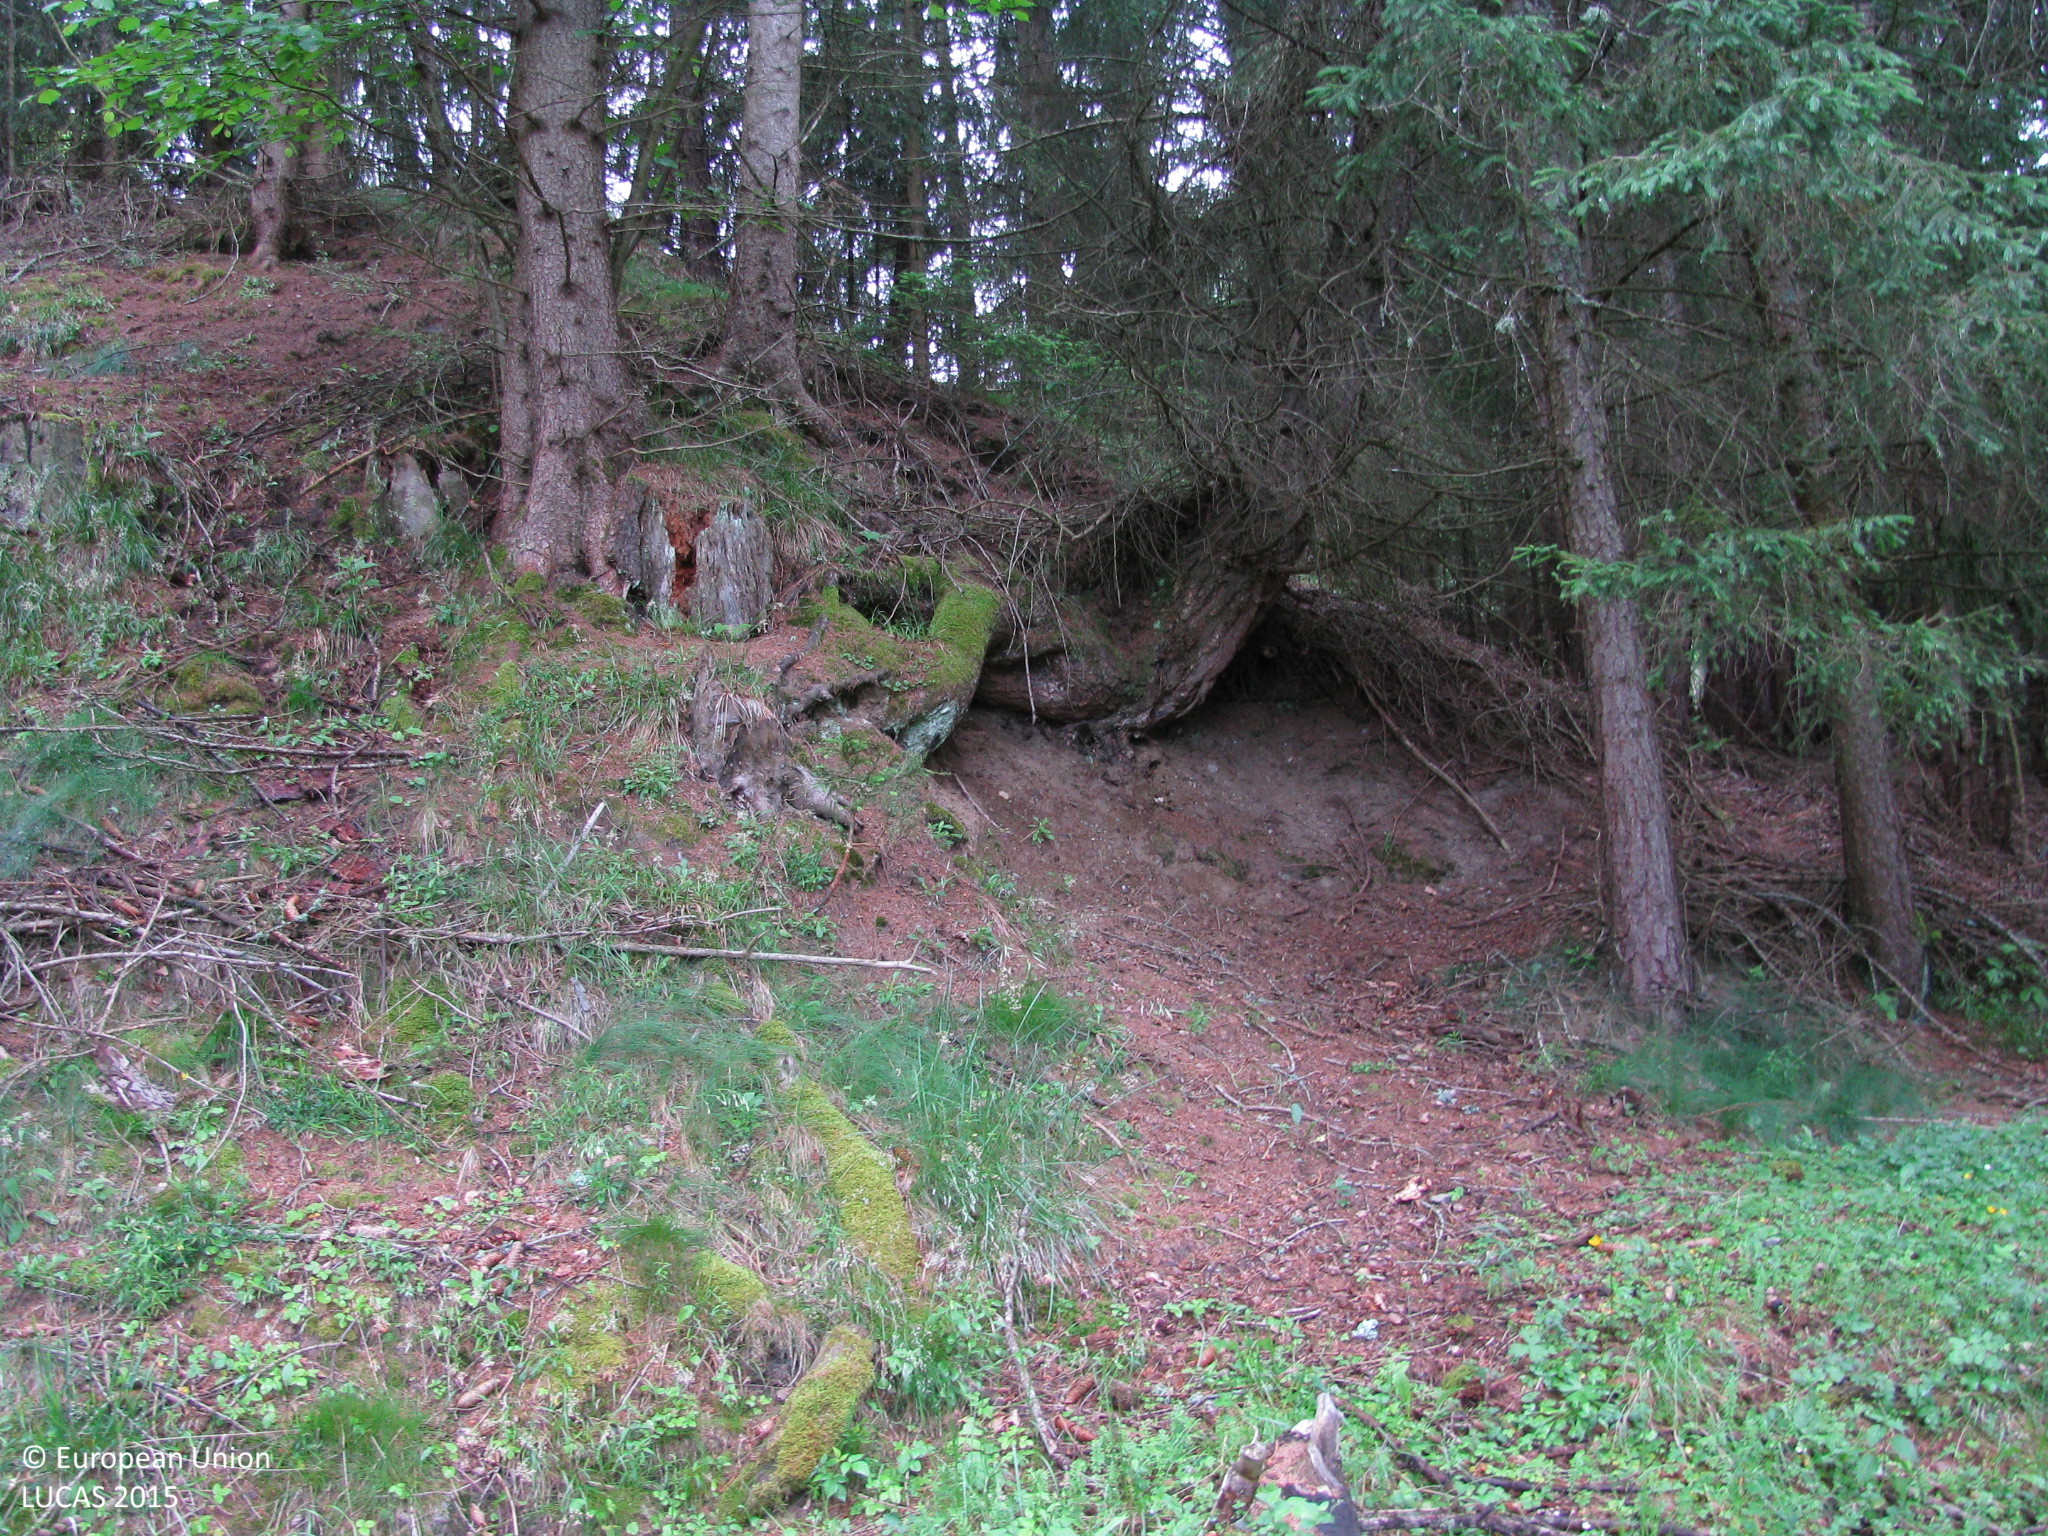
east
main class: Woodland
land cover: Spruce dominated coniferous woodland
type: alpine coniferous forest
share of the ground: 50 - 75 %
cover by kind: coniferous forest trees 60 %, herbaceous plants 40 %
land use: Forestry
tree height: > 5 m
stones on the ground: < 10 %
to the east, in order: Spruce dominated coniferous woodland; Grassland without tree/shrub cover; Spontaneously vegetated surfaces; Spruce dominated coniferous woodland; Fences; Spruce dominated coniferous woodland; Paved roads, cycling and walking lanes; Spruce dominated coniferous woodland; Spontaneously vegetated surfaces
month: June
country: AT
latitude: 47.1056
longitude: 14.4655
